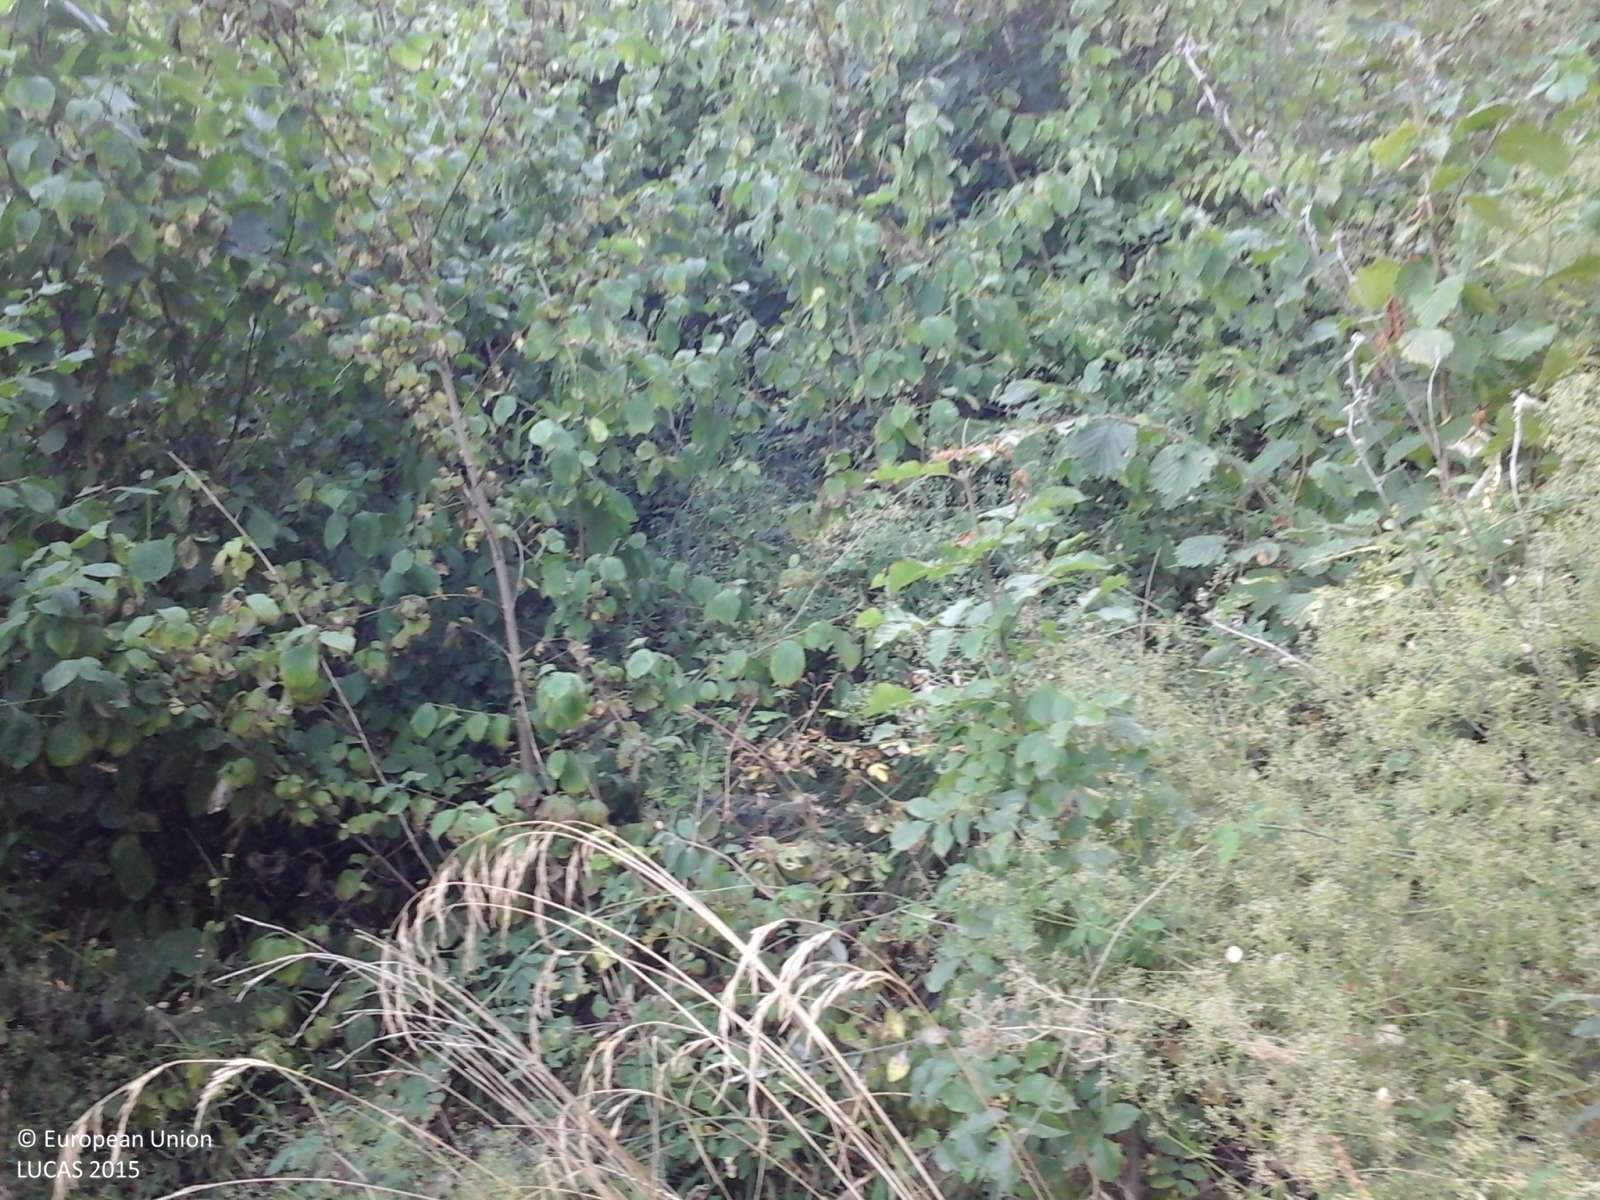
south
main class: Woodland
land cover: Broadleaved woodland
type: thermophilous deciduous forest
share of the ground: > 75 %
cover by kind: broadleaved forest trees 100 %
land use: Forestry
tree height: > 5 m
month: July
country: IT
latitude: 45.5359
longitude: 10.9844
